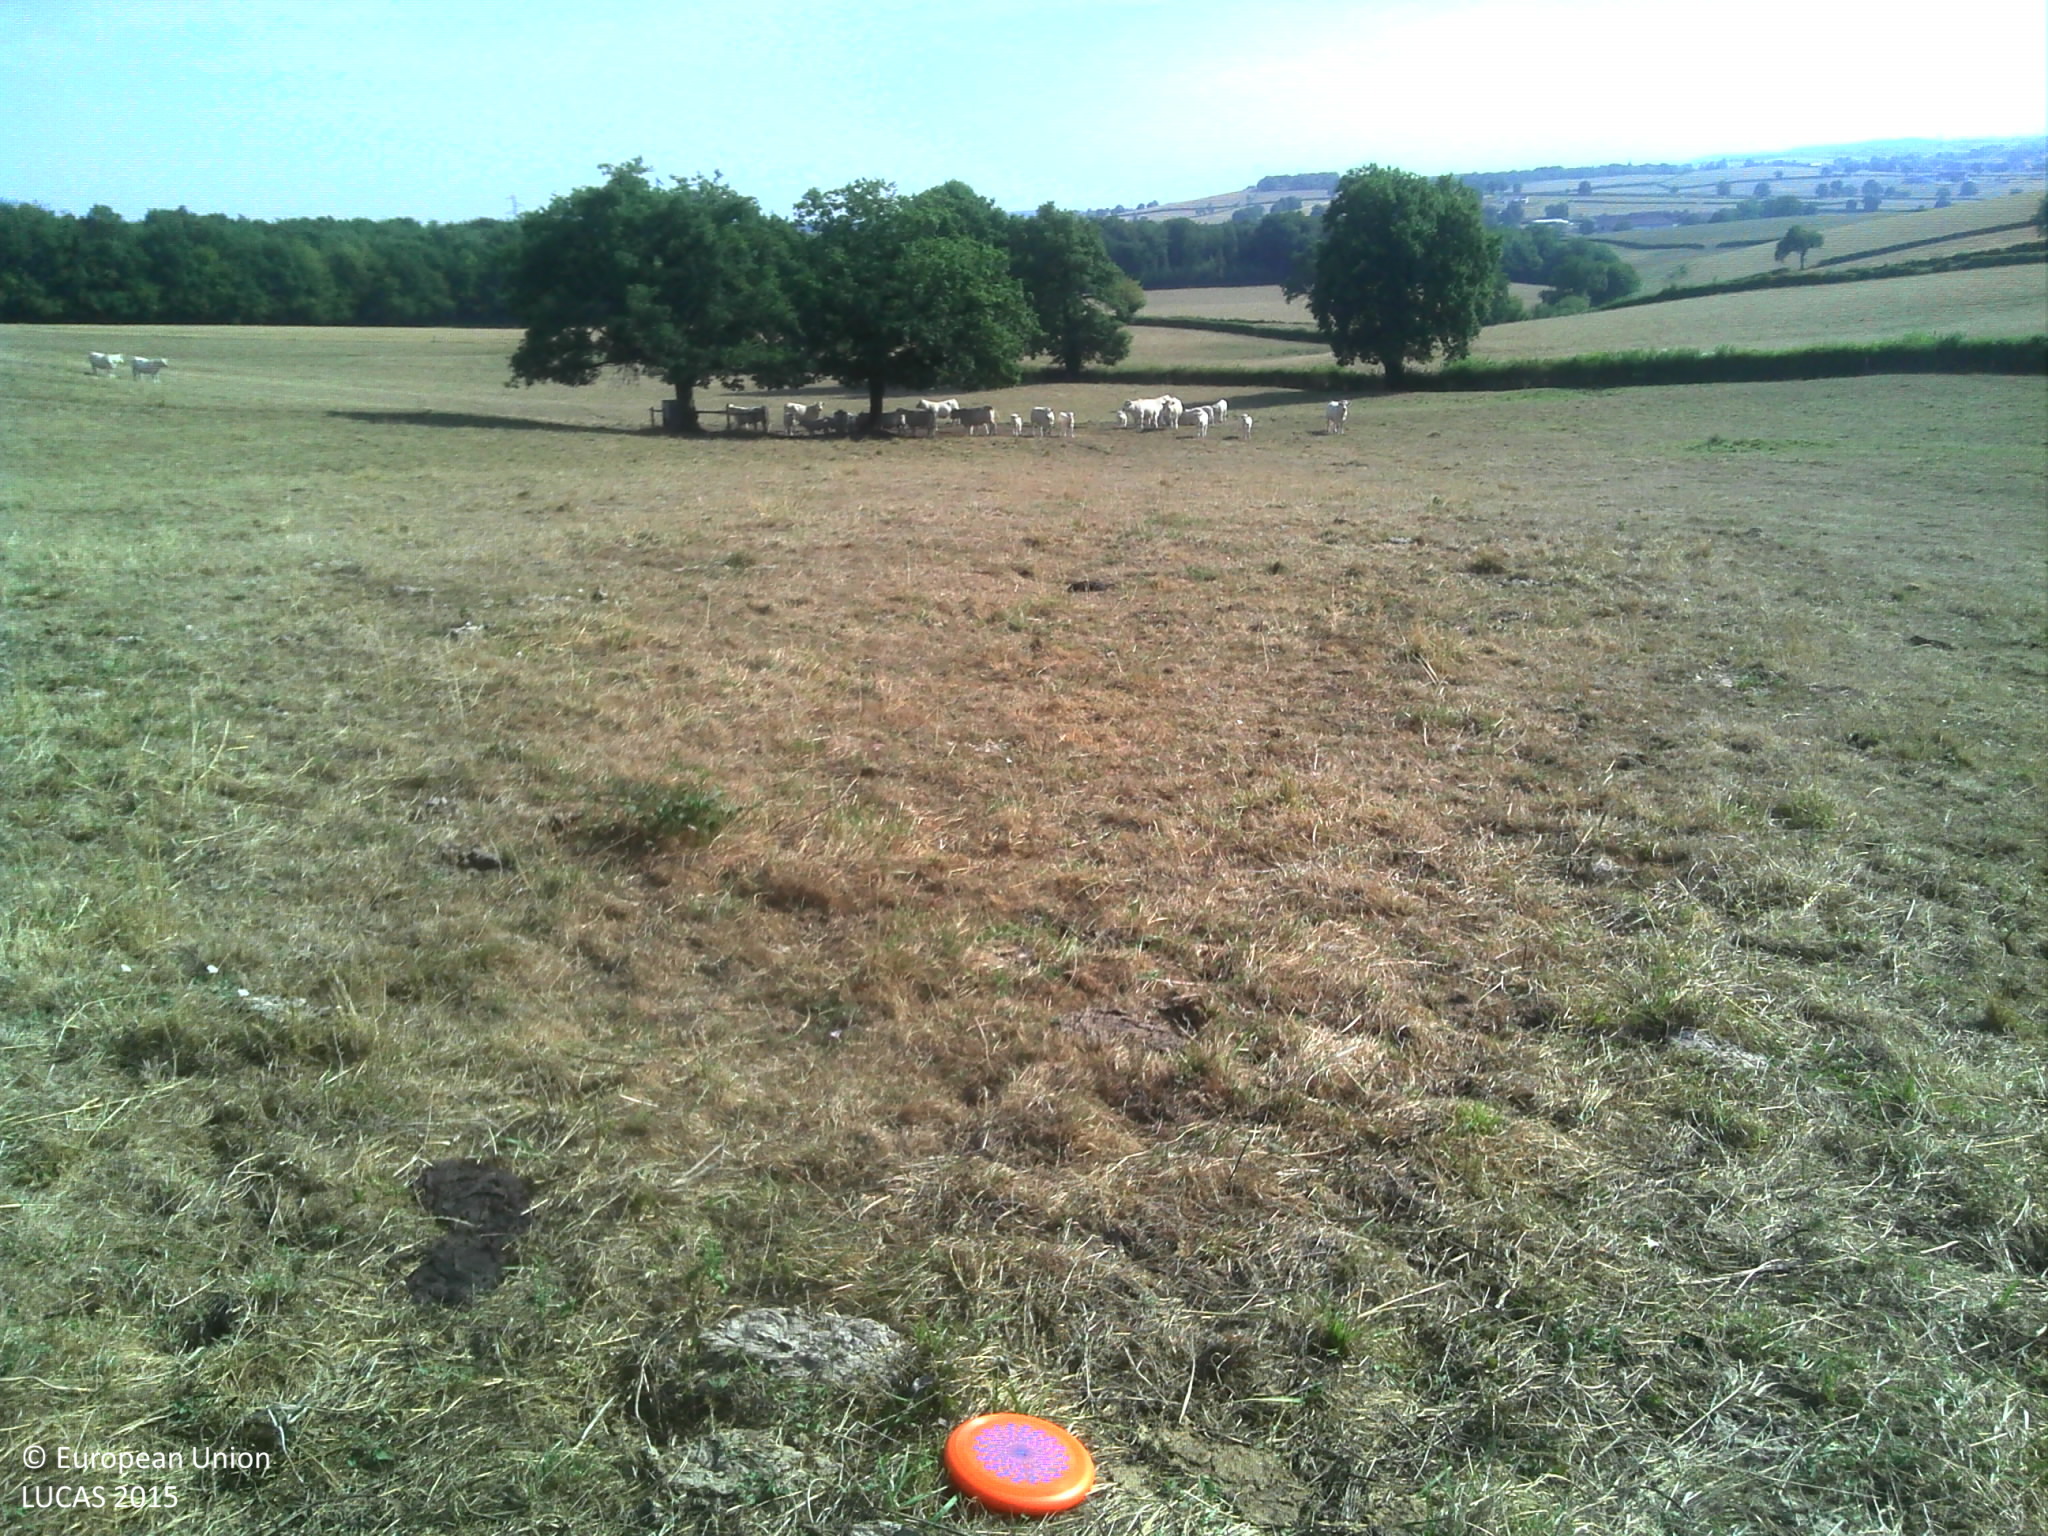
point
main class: Grassland
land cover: Grassland without tree/shrub cover
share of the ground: > 75 %
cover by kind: herbaceous plants 100 %
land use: Agriculture (excluding fallow land and kitchen gardens)
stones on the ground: 10 - 25 %
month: August
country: FR
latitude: 46.6928
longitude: 4.4170
